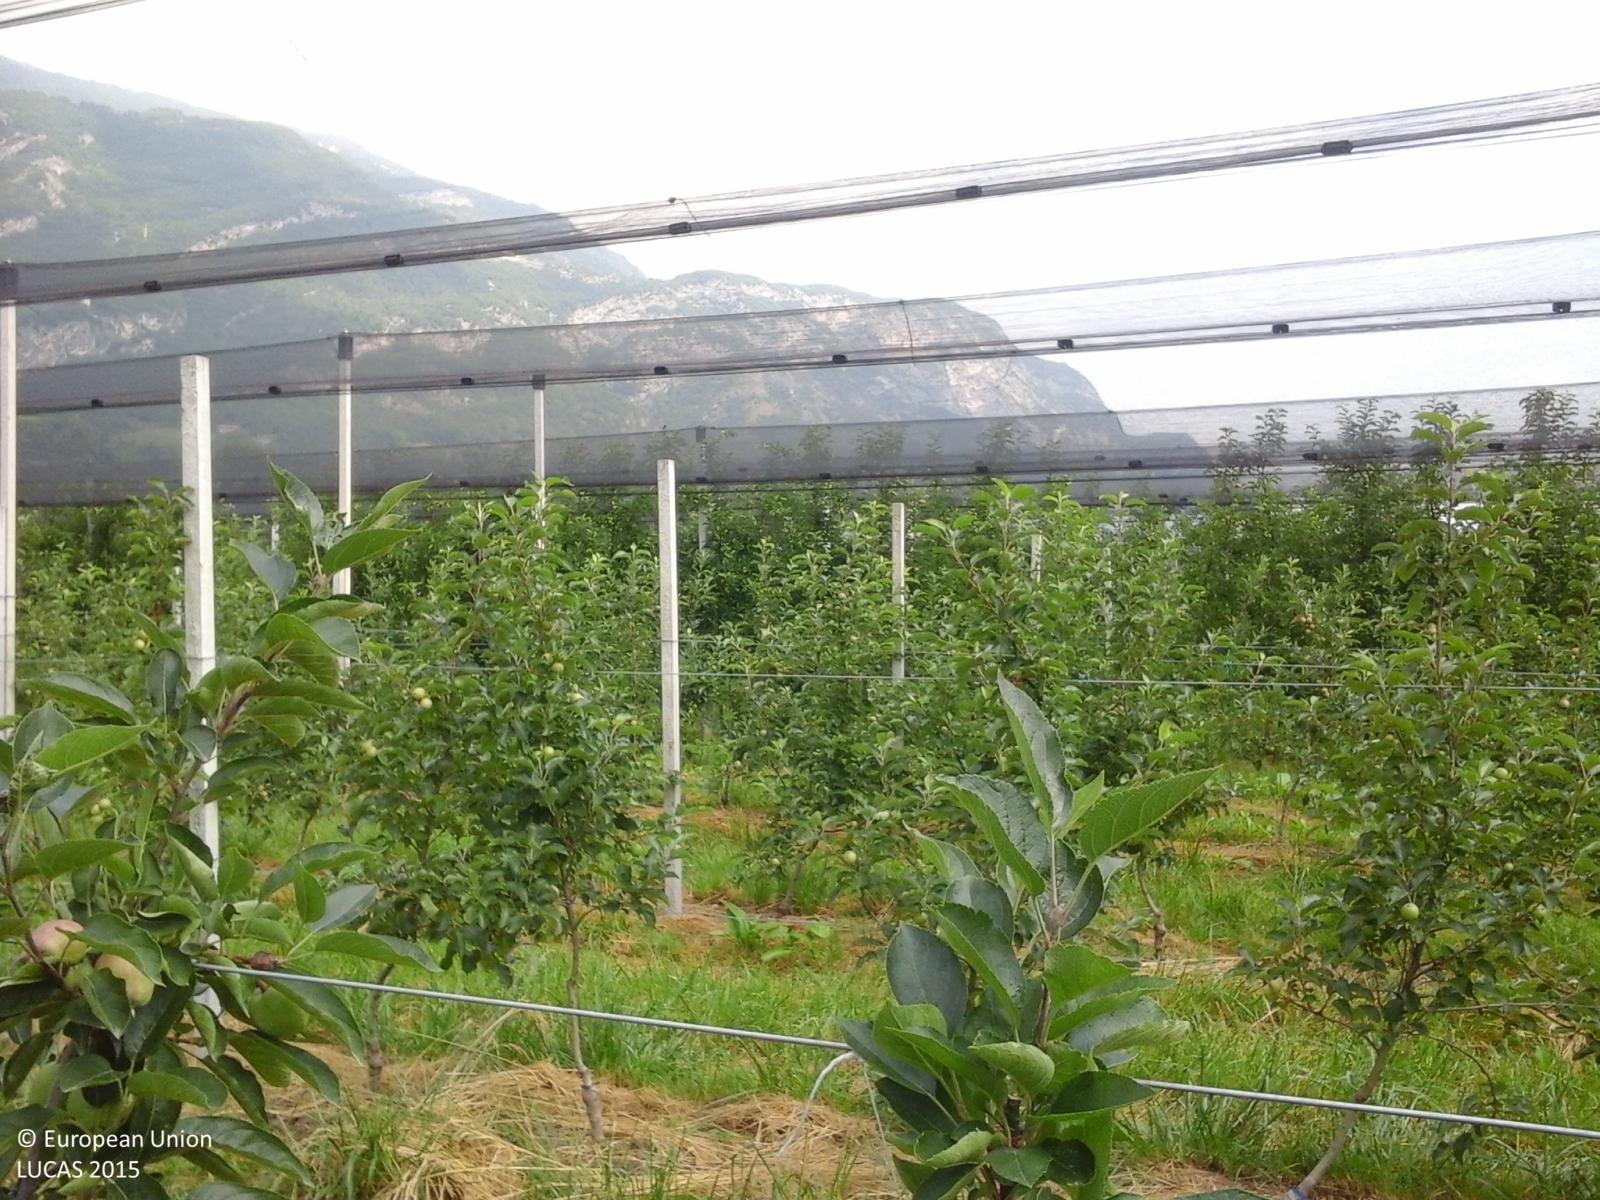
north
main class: Cropland
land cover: Apple fruit
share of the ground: < 10 %
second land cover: Grassland without tree/shrub cover
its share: > 75 %
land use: Agriculture (excluding fallow land and kitchen gardens)
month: June
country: IT
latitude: 45.9673
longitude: 11.0953
